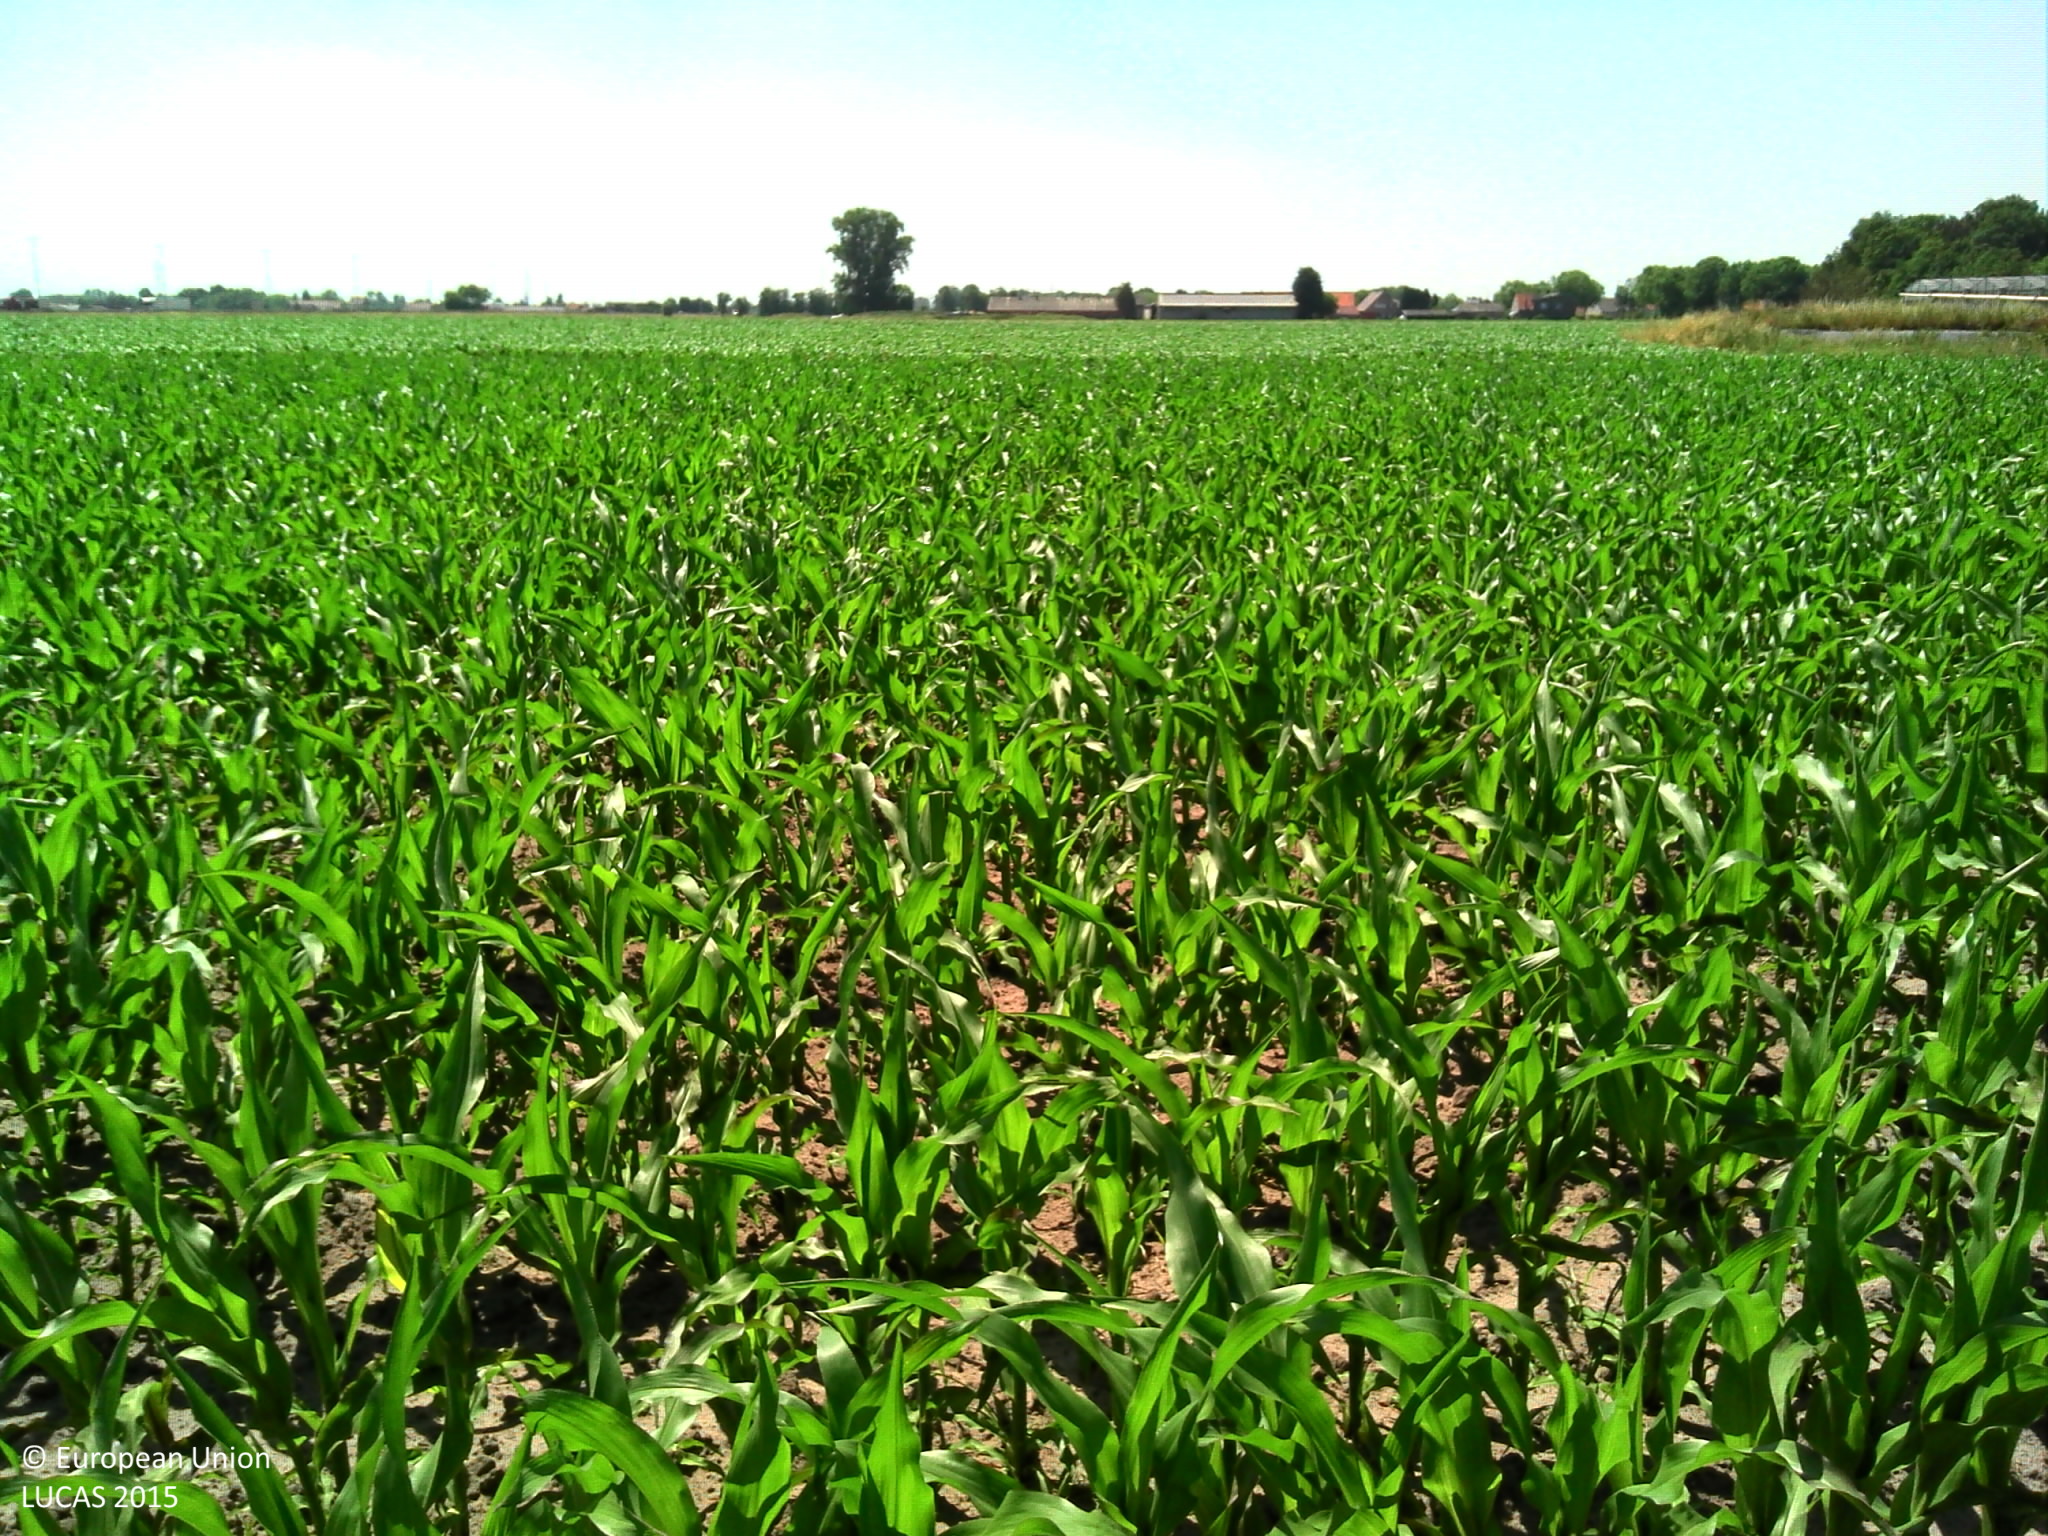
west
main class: Cropland
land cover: Maize
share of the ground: > 75 %
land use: Agriculture (excluding fallow land and kitchen gardens)
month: June
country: BE
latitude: 51.2157
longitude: 3.6506
